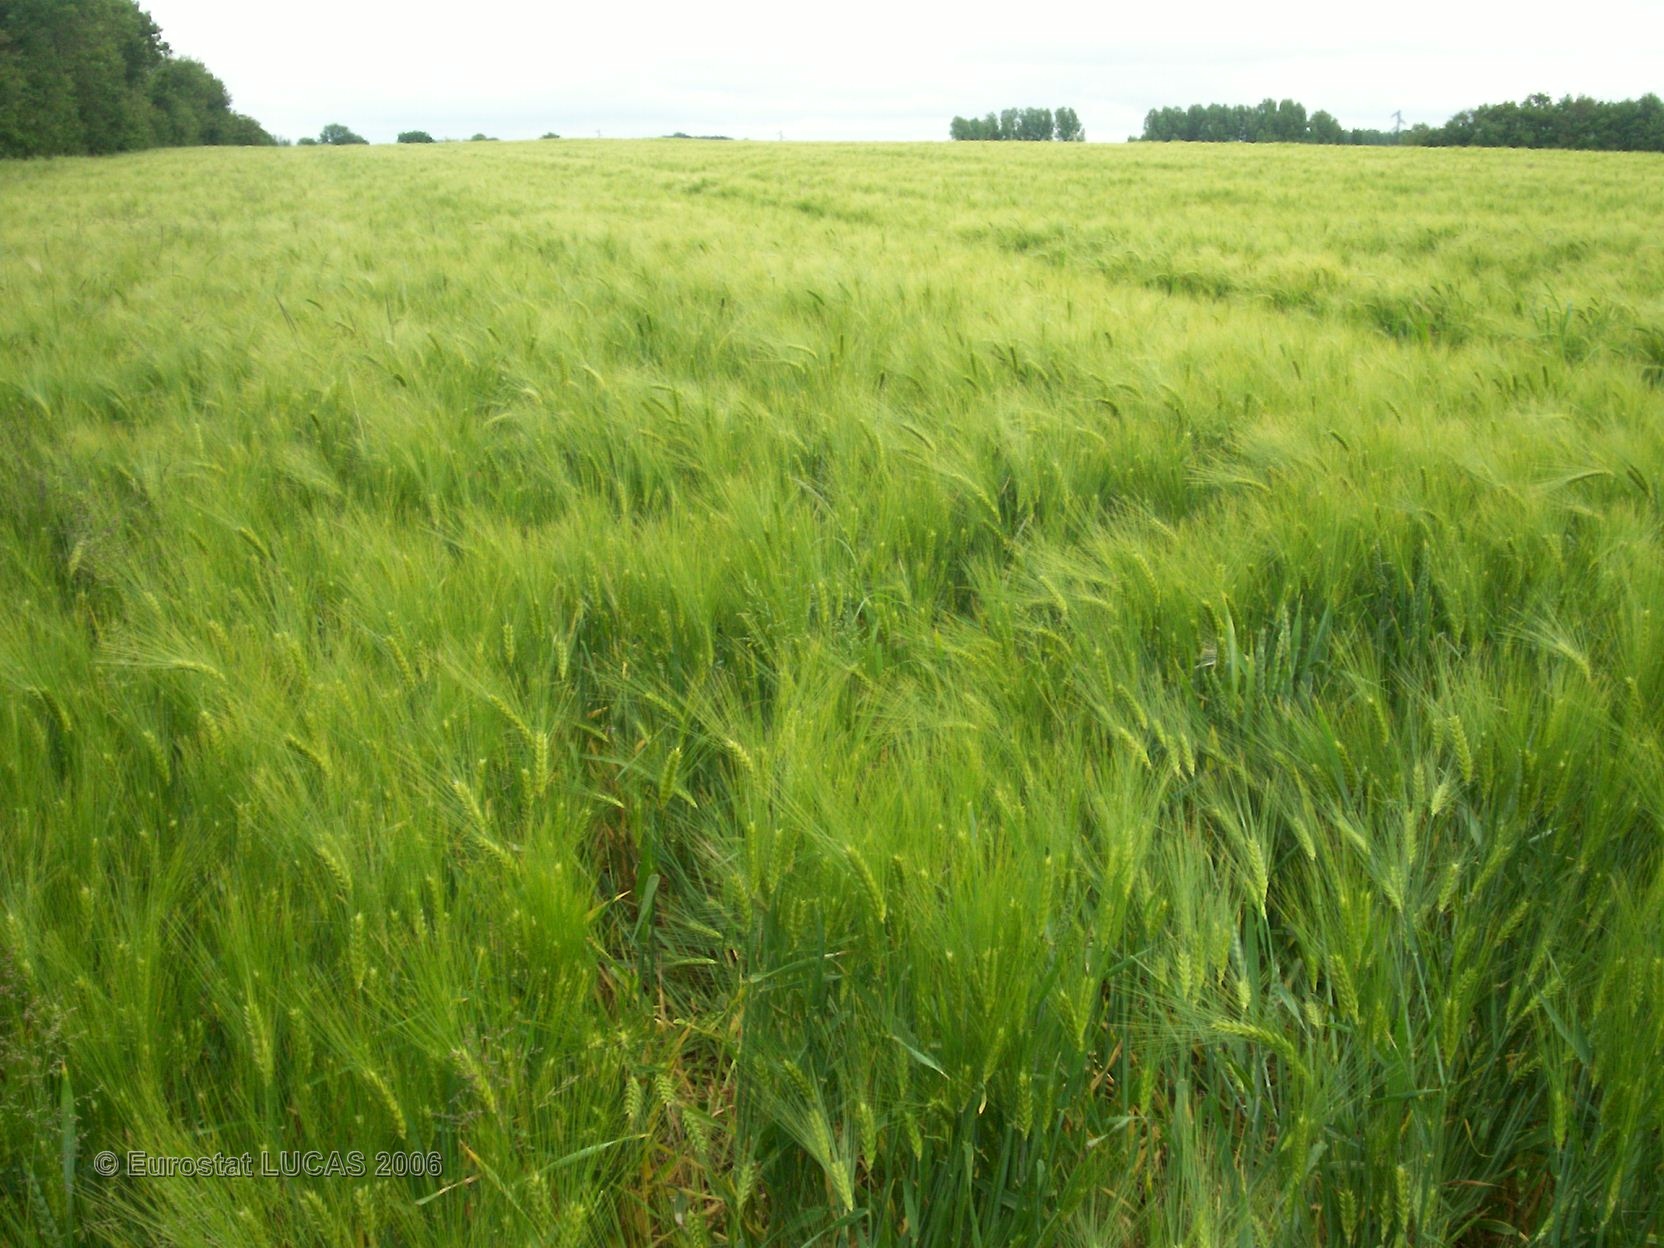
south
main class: Cropland
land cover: Barley
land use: Agriculture (excluding fallow land and kitchen gardens)
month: May
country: FR
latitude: 46.2919
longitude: 0.5206
